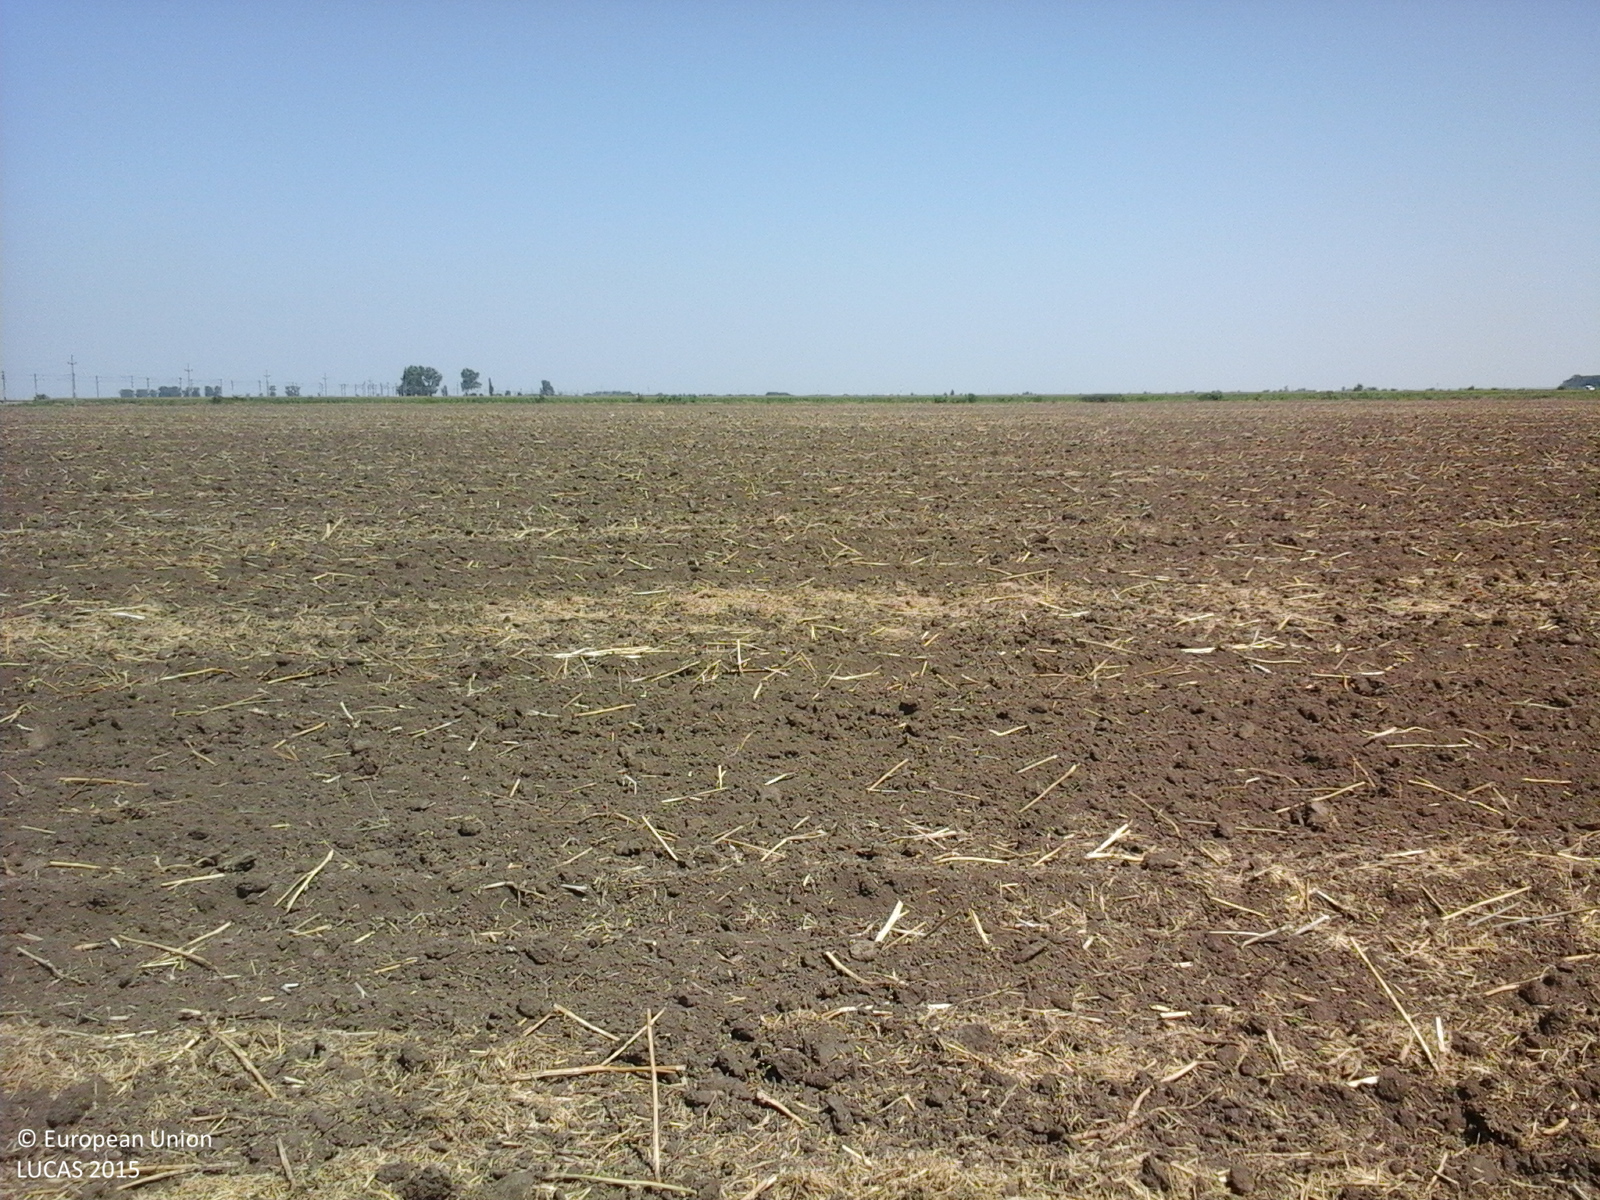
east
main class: Cropland
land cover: Rape and turnip rape
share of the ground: < 10 %
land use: Agriculture (excluding fallow land and kitchen gardens)
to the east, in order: Rape and turnip rape
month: July
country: RO
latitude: 44.4313
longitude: 27.0767
